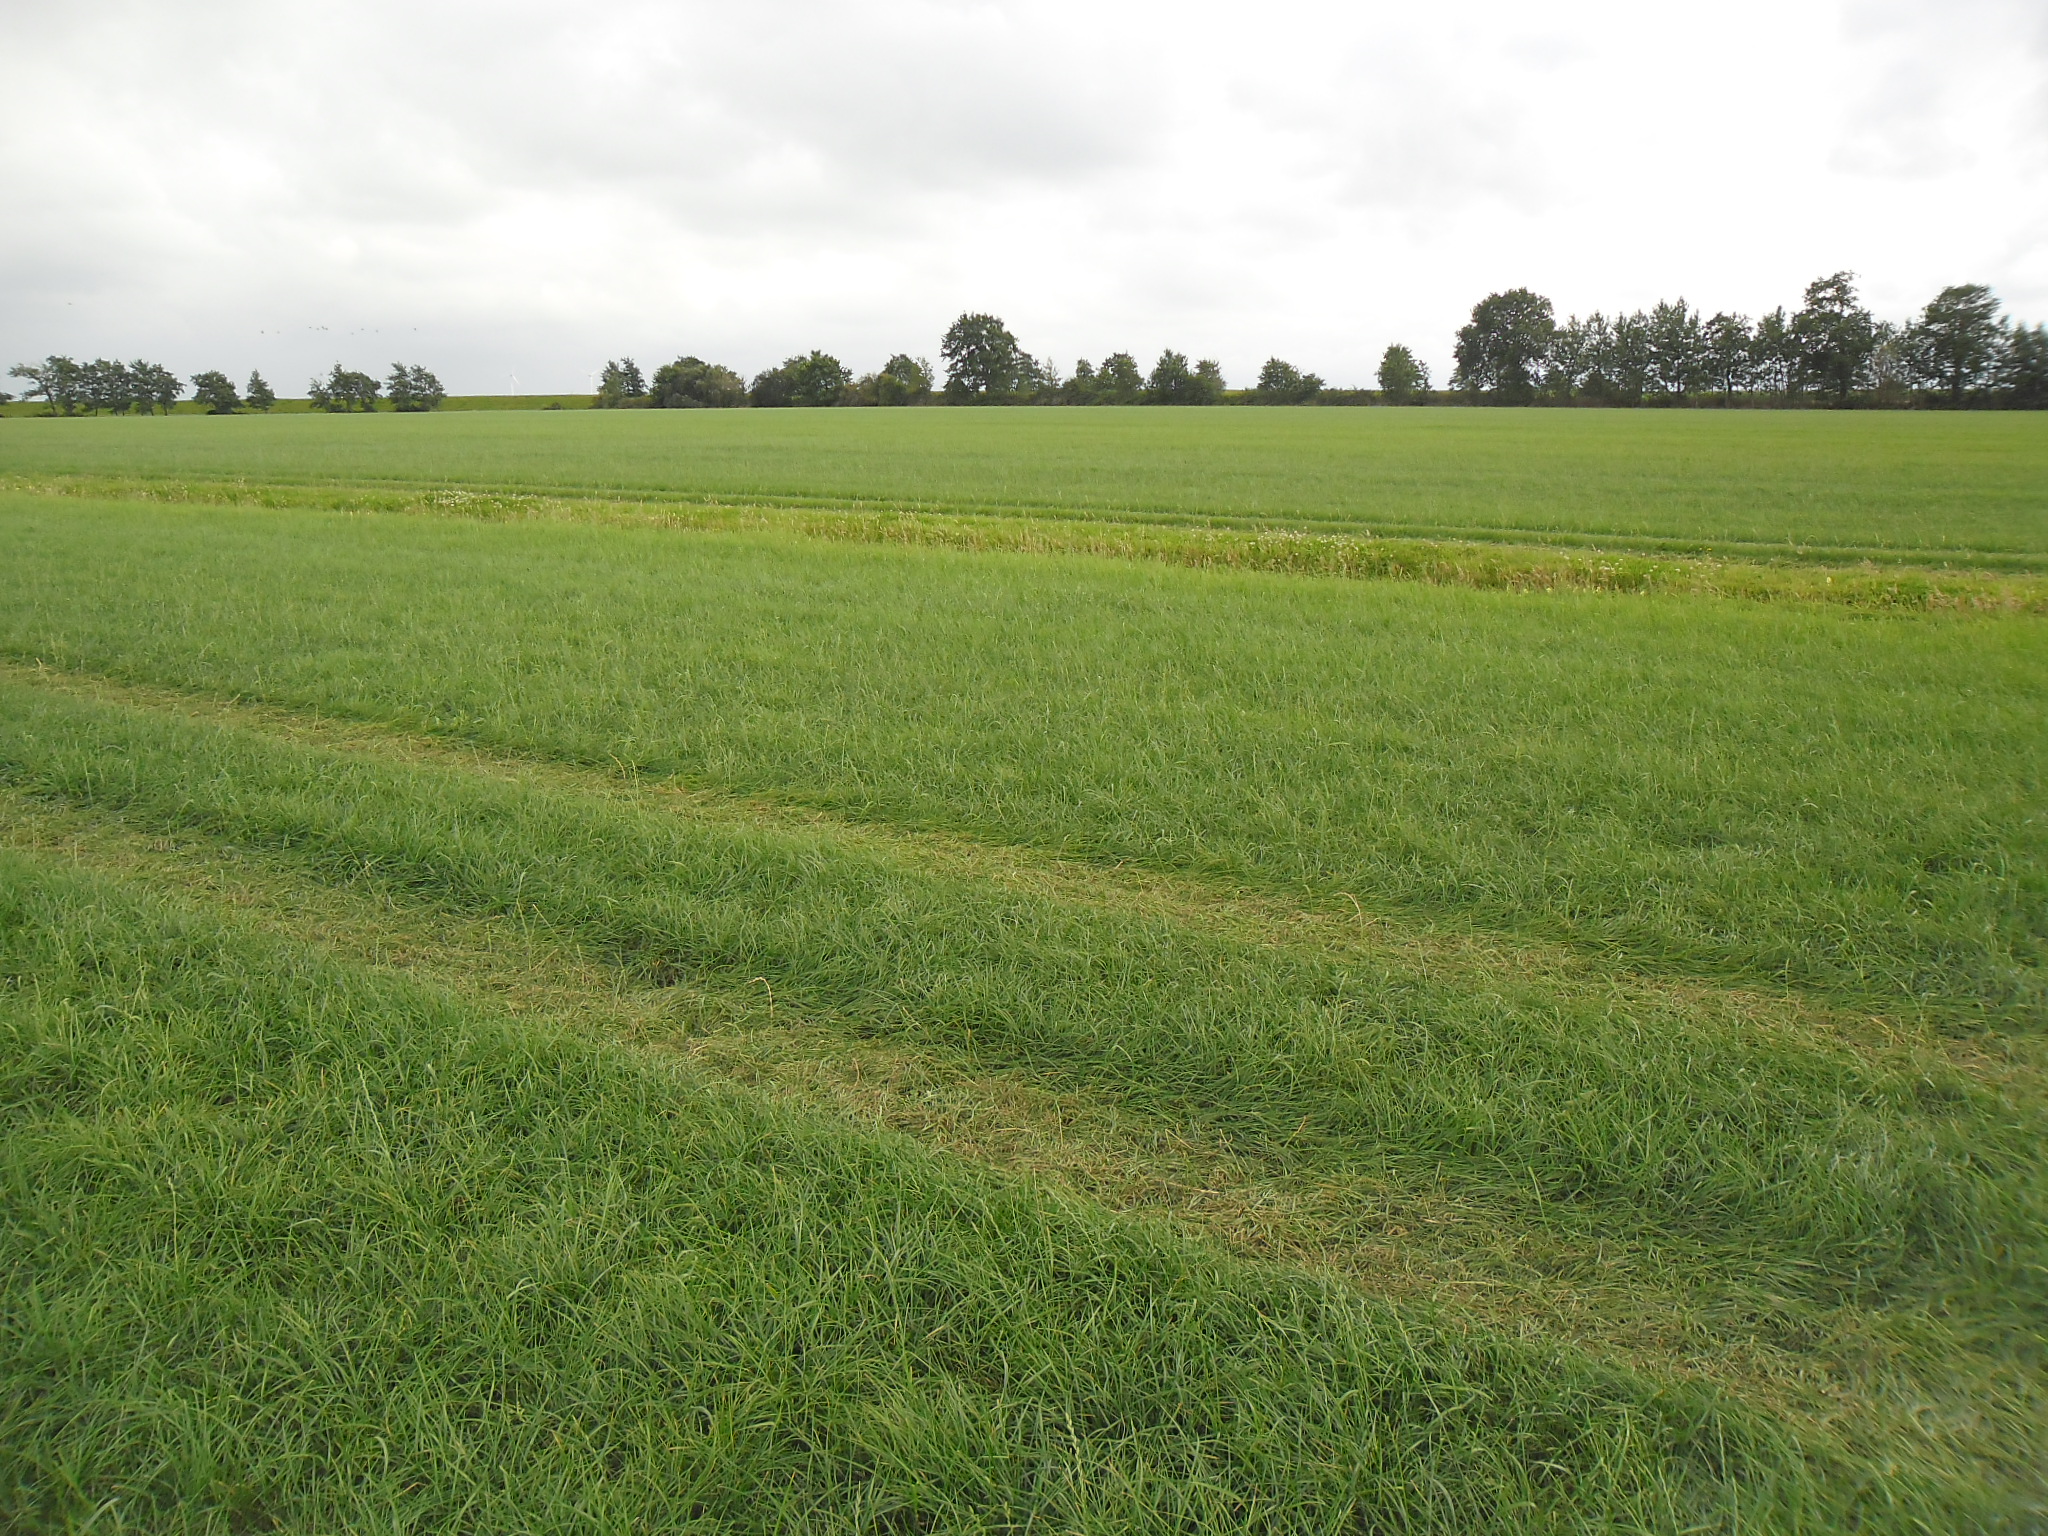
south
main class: Grassland
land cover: Grassland without tree/shrub cover
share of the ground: > 75 %
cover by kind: herbaceous plants 100 %
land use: Agriculture (excluding fallow land and kitchen gardens)
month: August
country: NL
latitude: 52.8536
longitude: 5.5882
